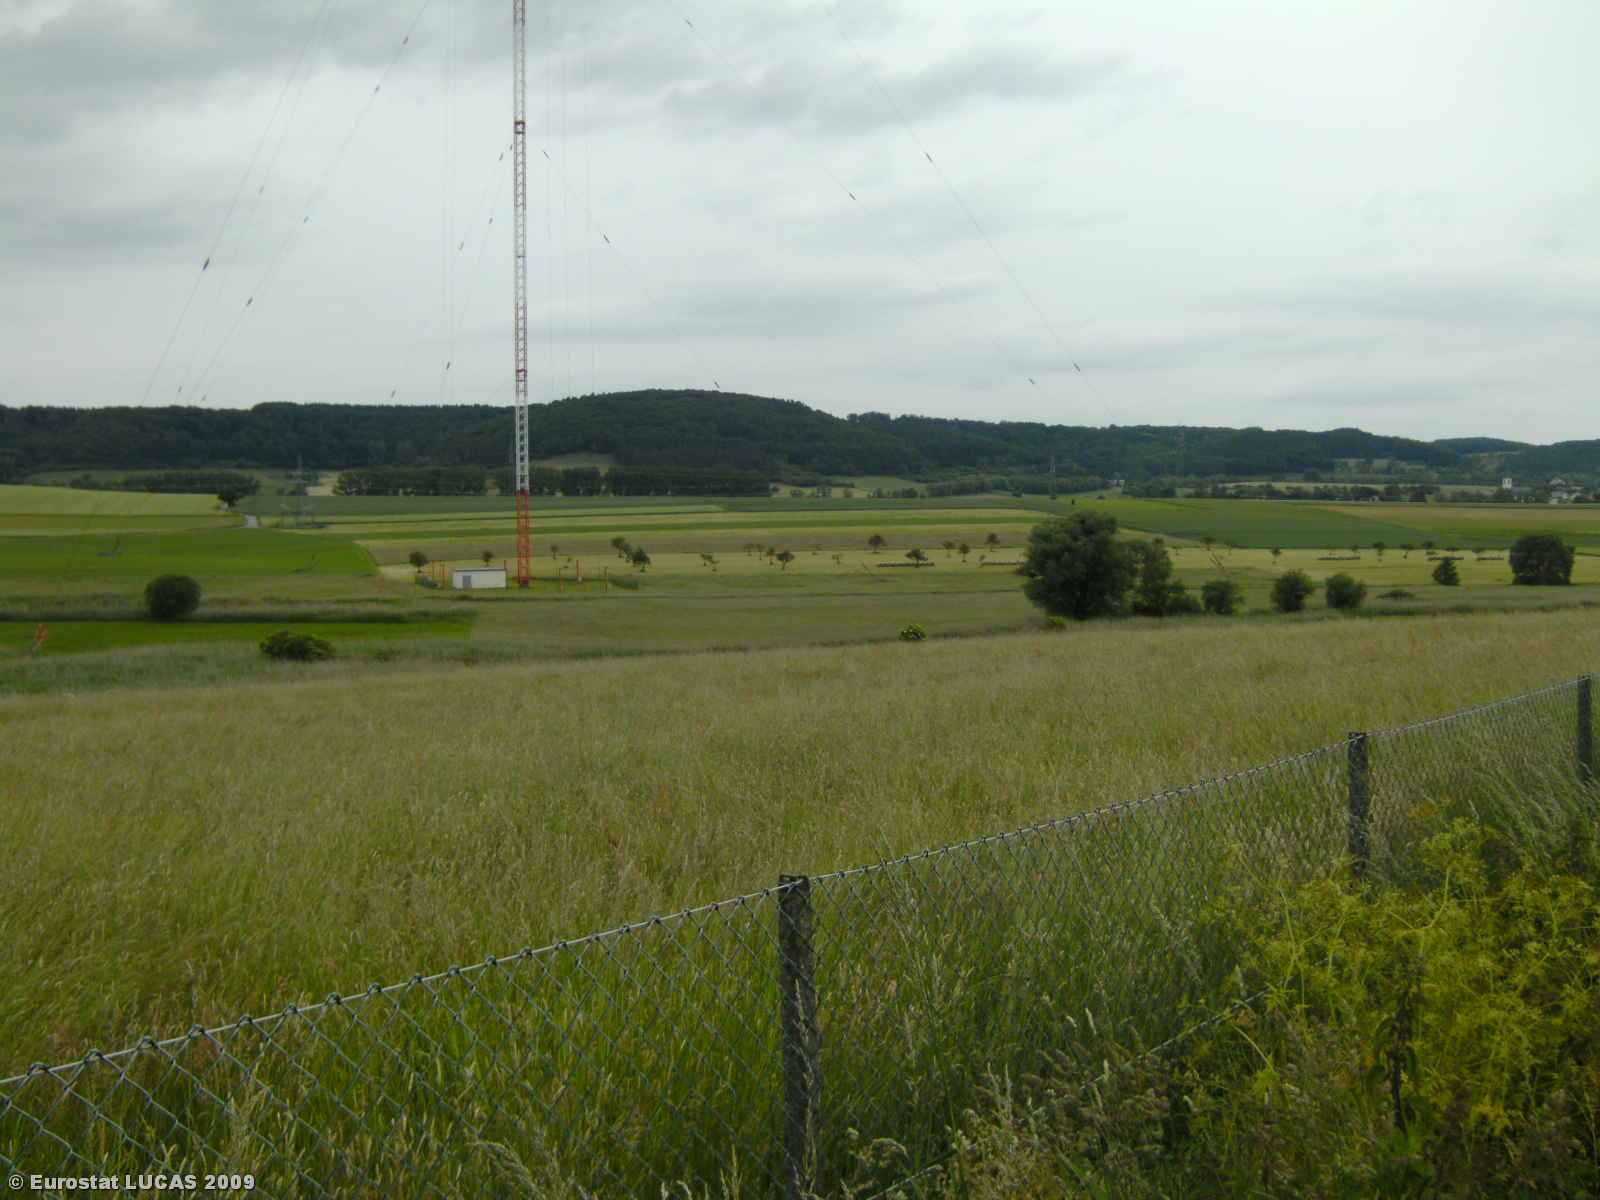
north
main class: Grassland
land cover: Grassland without tree/shrub cover
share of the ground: > 75 %
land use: Agriculture (excluding fallow land and kitchen gardens)
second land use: Telecommunication
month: June
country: LU
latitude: 49.7289
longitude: 6.3232
